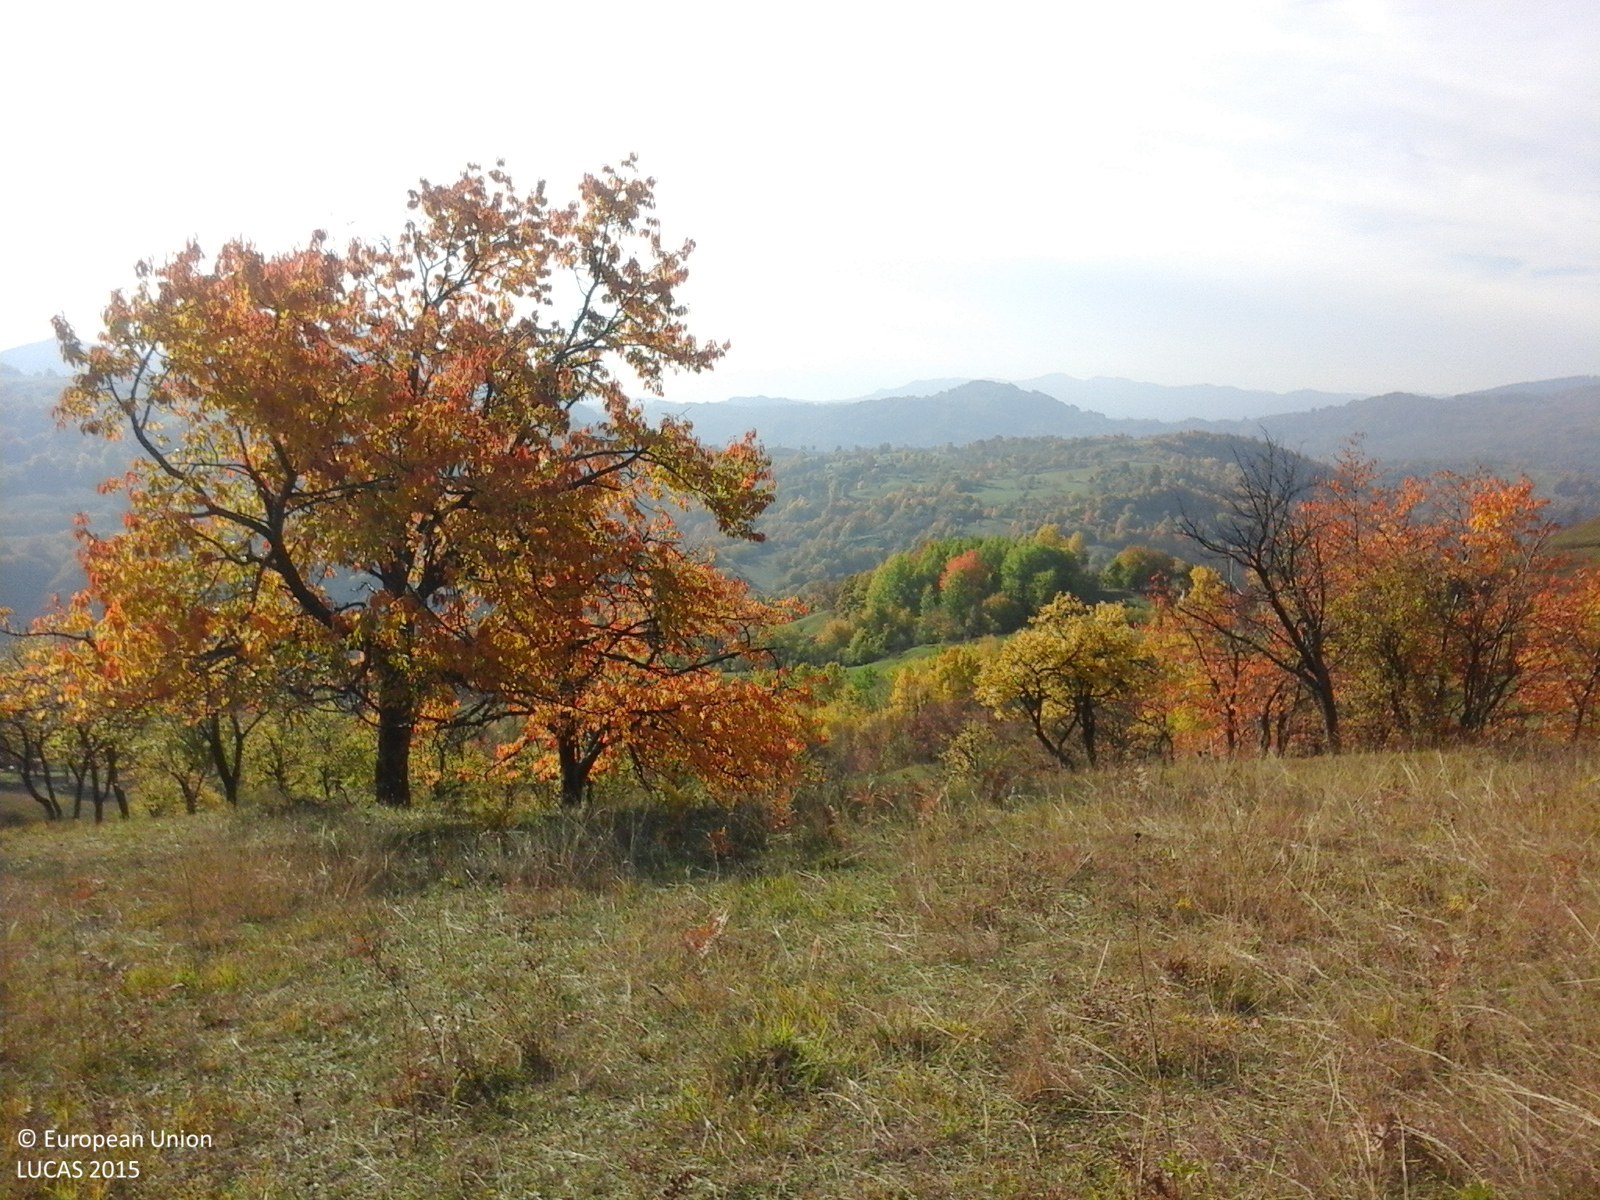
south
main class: Cropland
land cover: Other fruit trees and berries
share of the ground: > 75 %
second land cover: Grassland without tree/shrub cover
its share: > 75 %
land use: Agriculture (excluding fallow land and kitchen gardens)
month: October
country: RO
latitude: 45.8130
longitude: 26.7227
